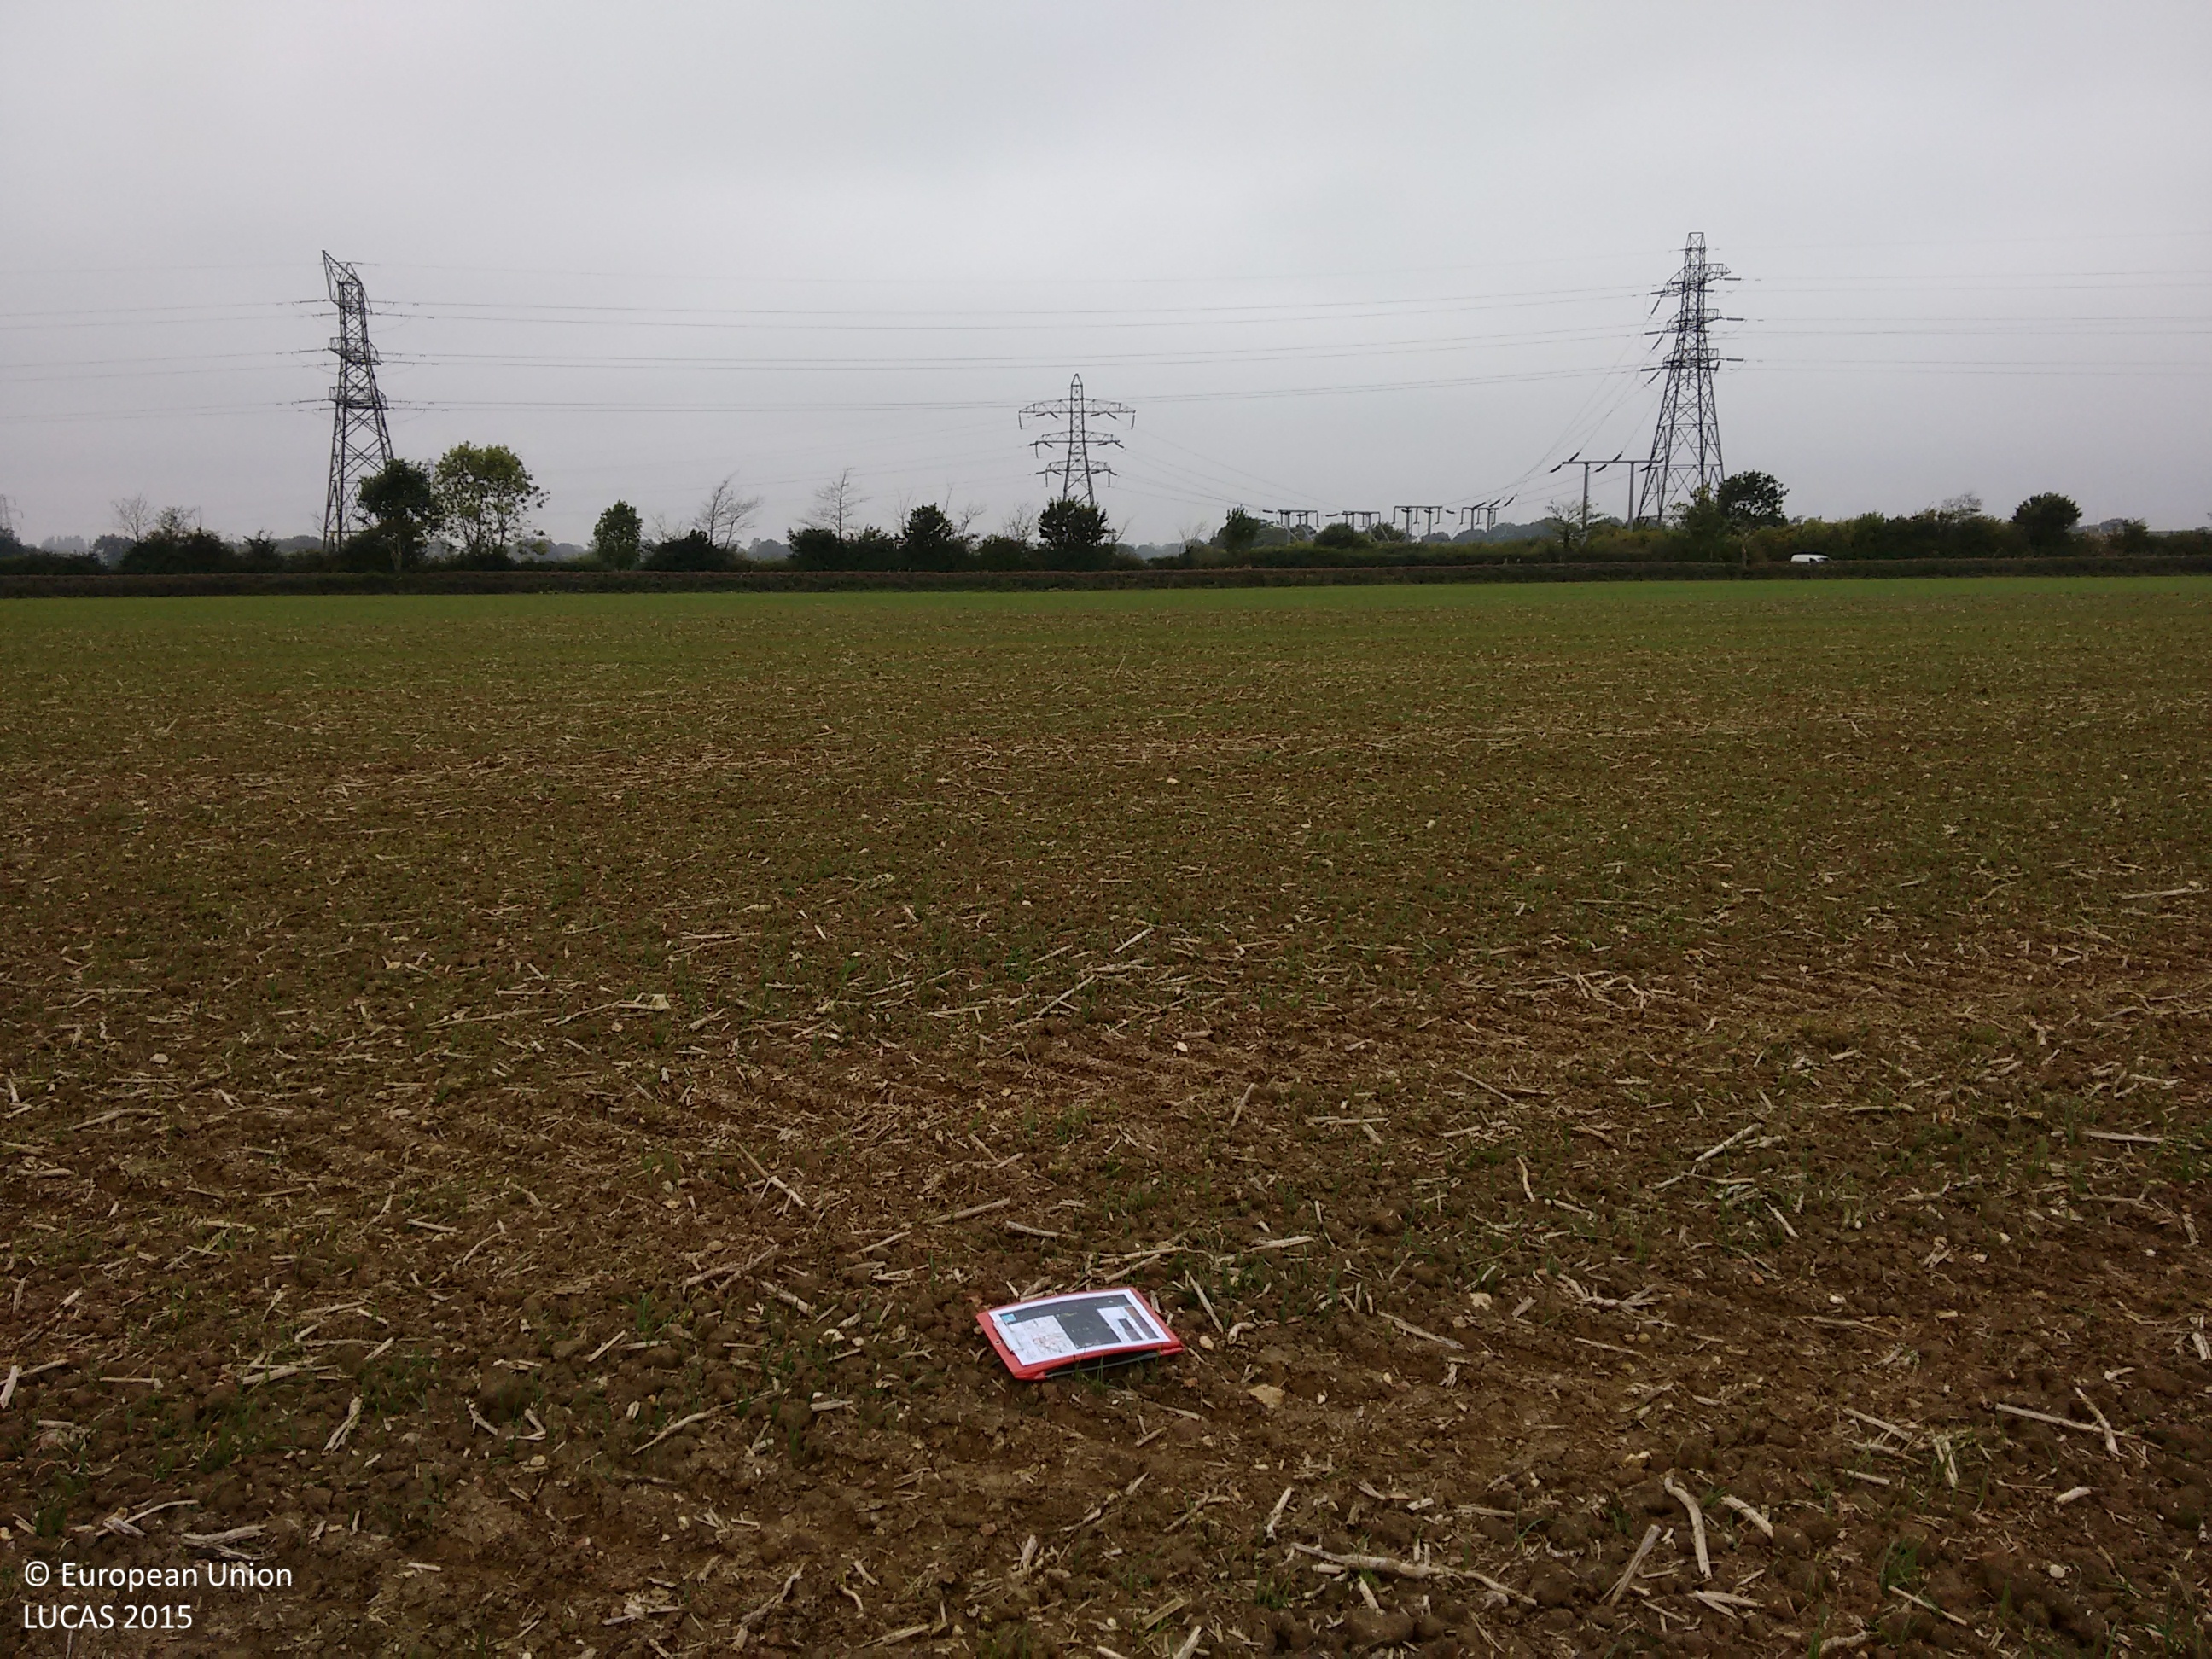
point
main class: Cropland
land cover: Common wheat
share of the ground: < 10 %
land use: Agriculture (excluding fallow land and kitchen gardens)
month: October
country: GB
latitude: 52.3956
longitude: 1.4717
